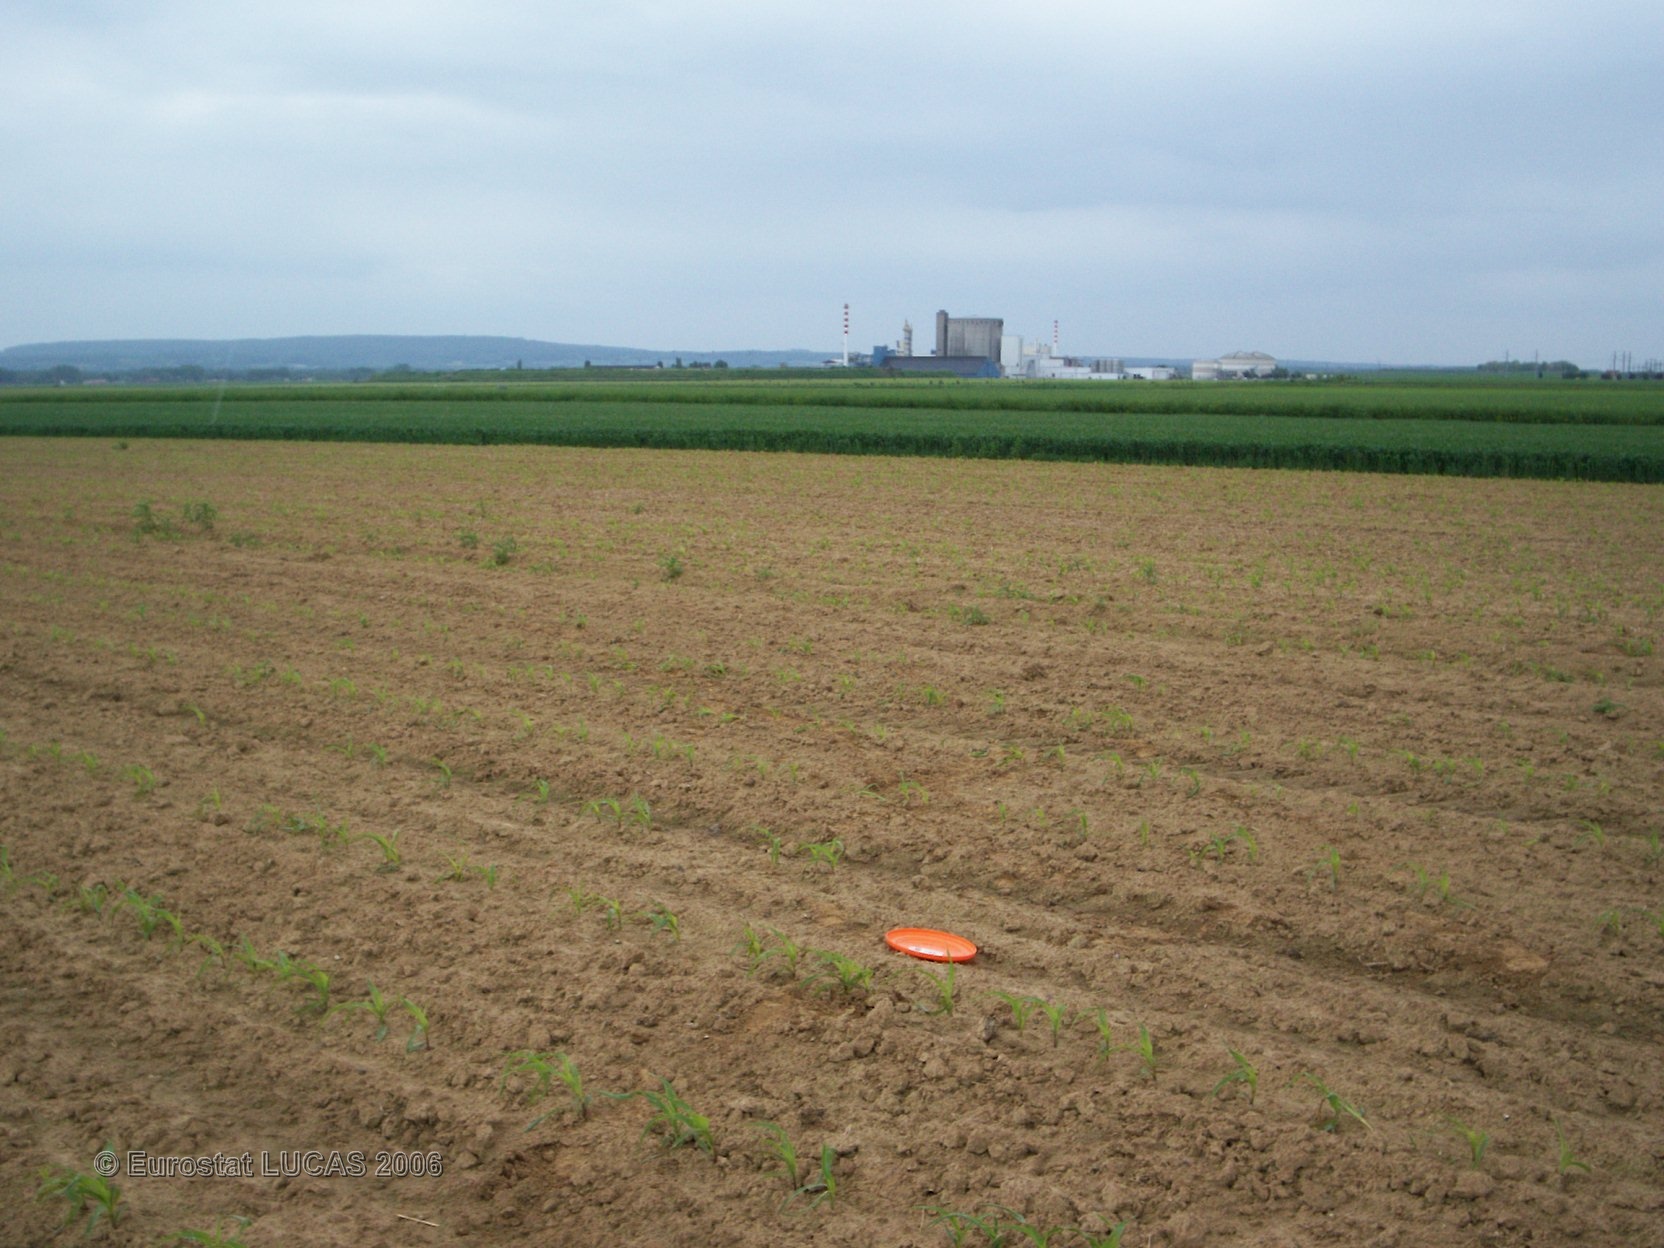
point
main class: Cropland
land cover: Maize
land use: Agriculture (excluding fallow land and kitchen gardens)
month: June
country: FR
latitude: 49.3707
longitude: 2.6763
